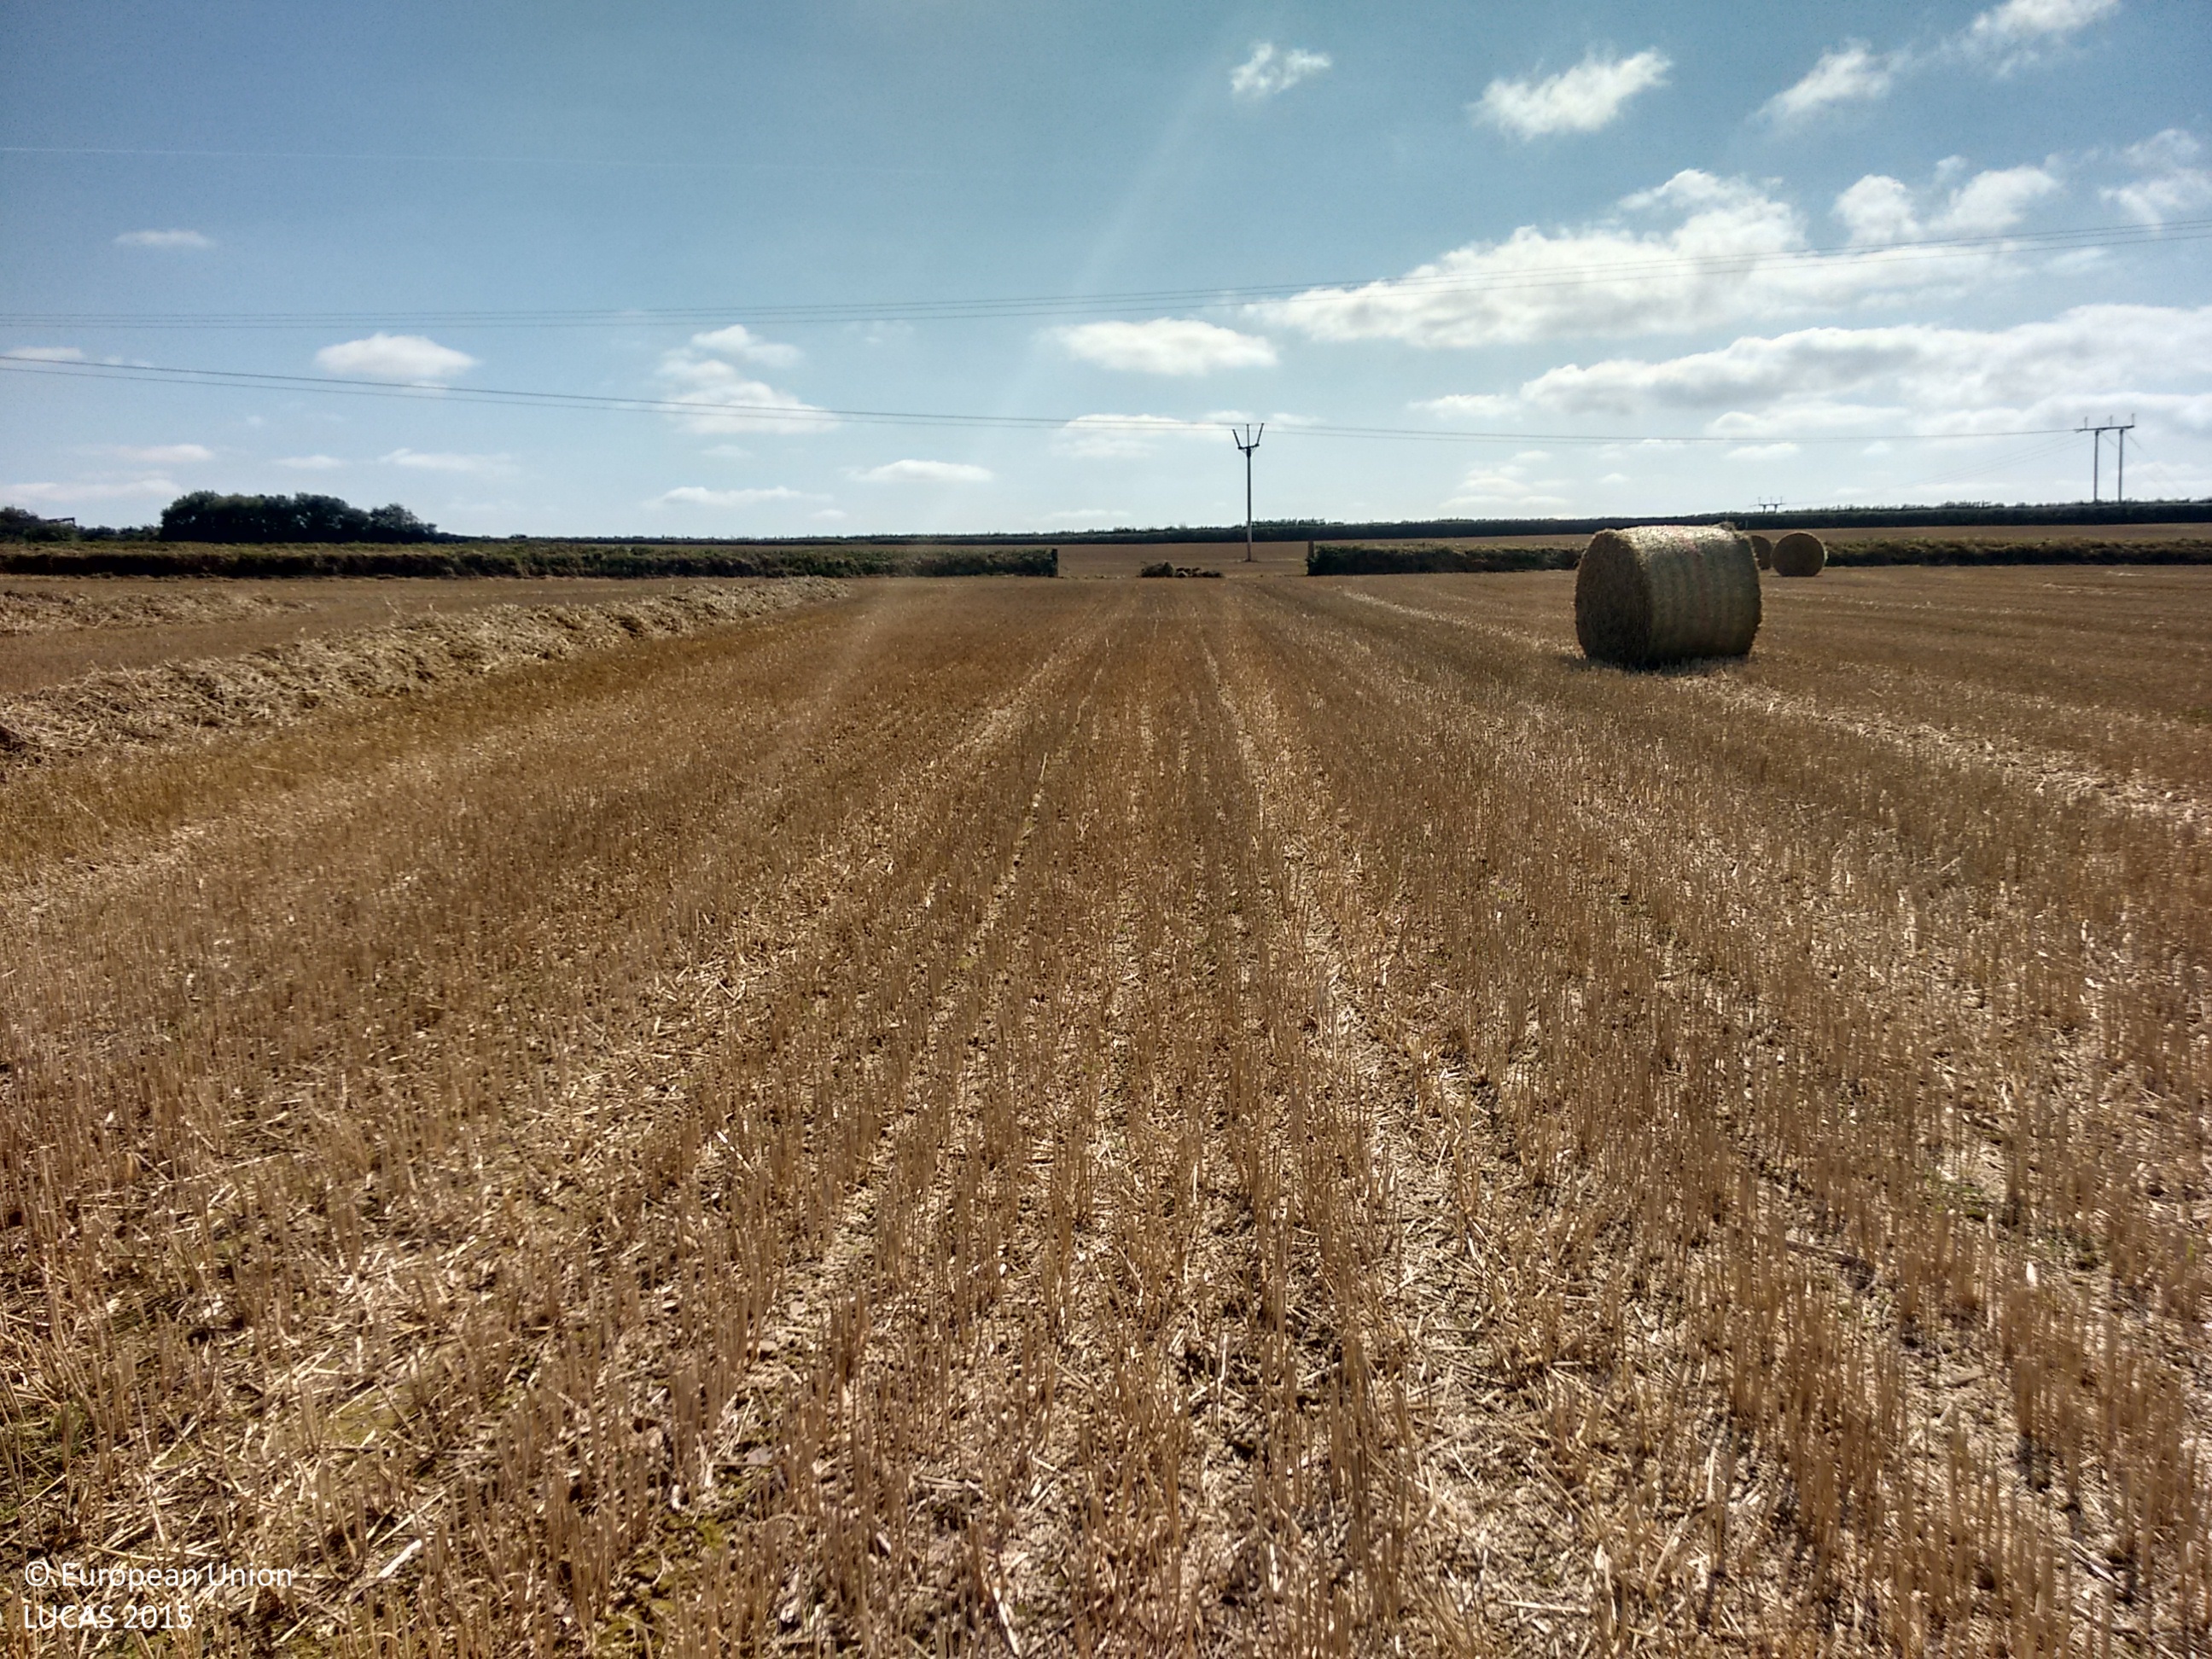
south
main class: Cropland
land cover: Barley
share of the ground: < 10 %
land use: Agriculture (excluding fallow land and kitchen gardens)
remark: Harvested field
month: September
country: GB
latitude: 51.0318
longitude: -4.1429
